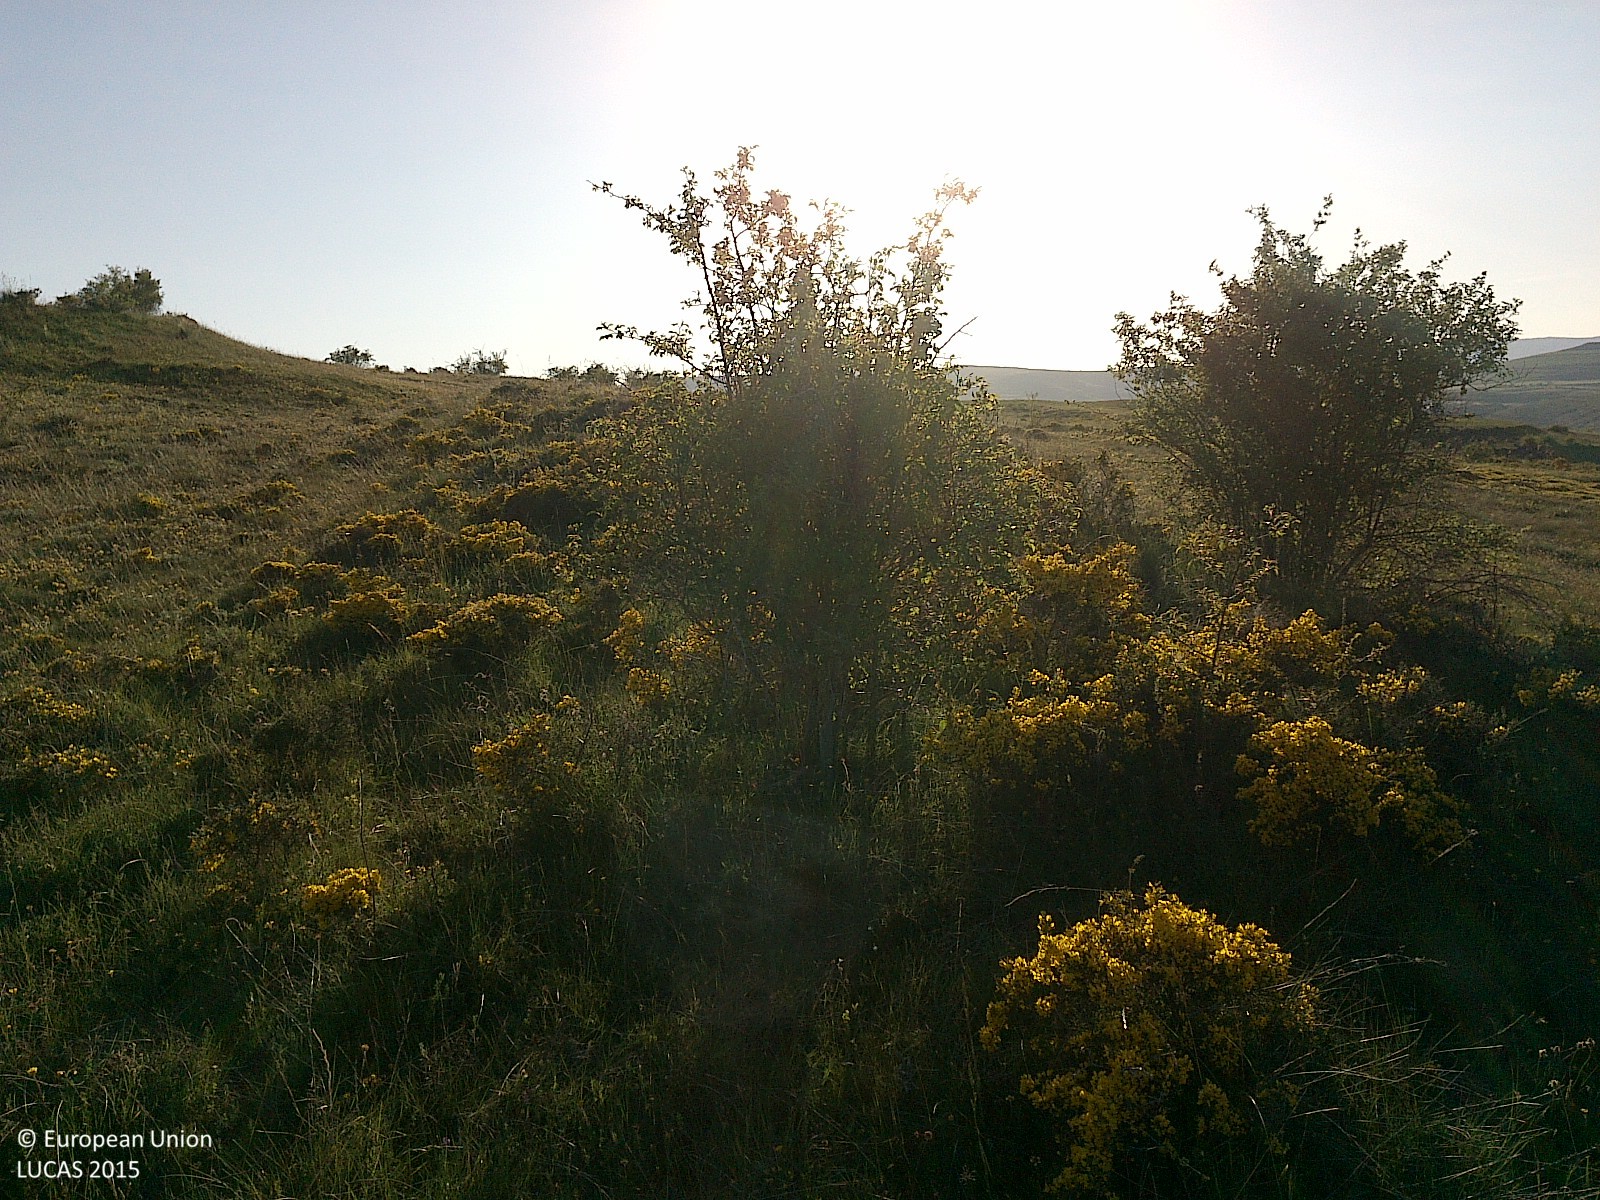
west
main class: Shrubland
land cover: Shrubland without tree cover
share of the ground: 50 - 75 %
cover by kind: shrubs 55 %, herbaceous plants 45 %
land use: Agriculture (excluding fallow land and kitchen gardens)
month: May
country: ES
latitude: 42.0114
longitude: -2.2946
